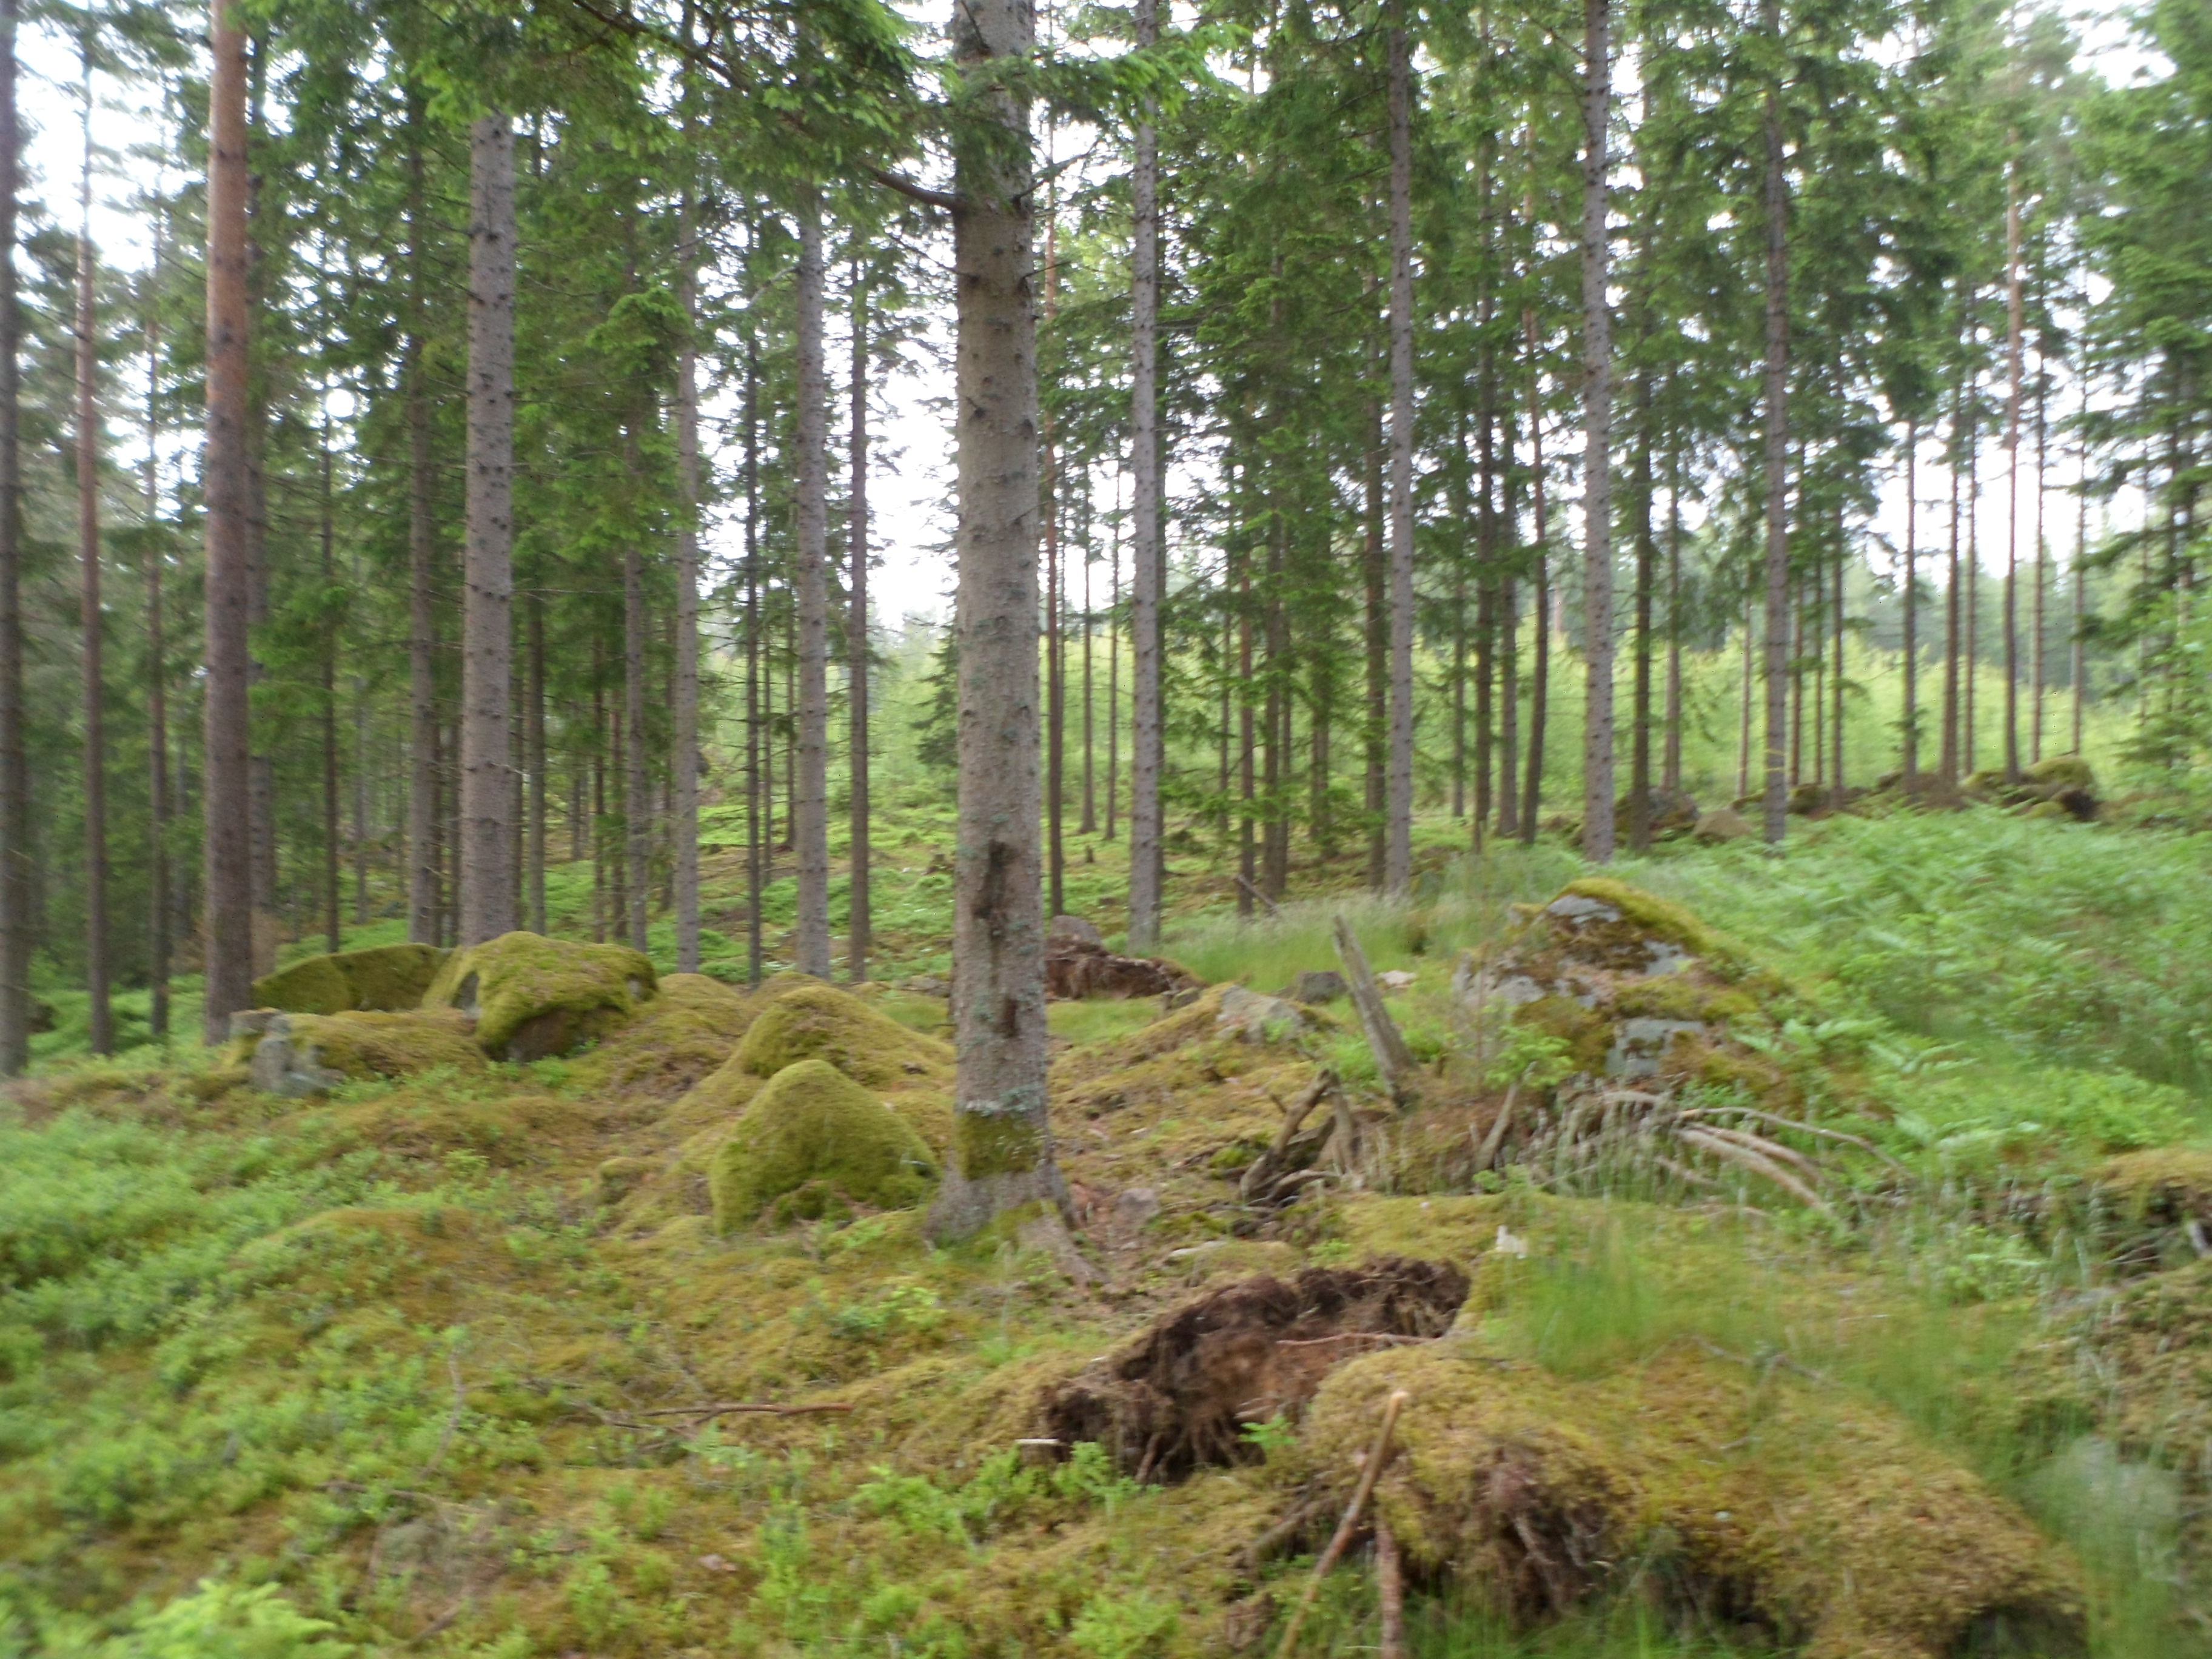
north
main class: Woodland
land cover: Spruce dominated coniferous woodland
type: boreal forest
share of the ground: 50 - 75 %
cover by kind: coniferous forest trees 55 %, shrubs 25 %, lichens and mosses 10 %, broadleaved forest trees 5 %, herbaceous plants 5 %
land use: Forestry
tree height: > 5 m
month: June
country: SE
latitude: 56.8795
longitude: 14.6080
